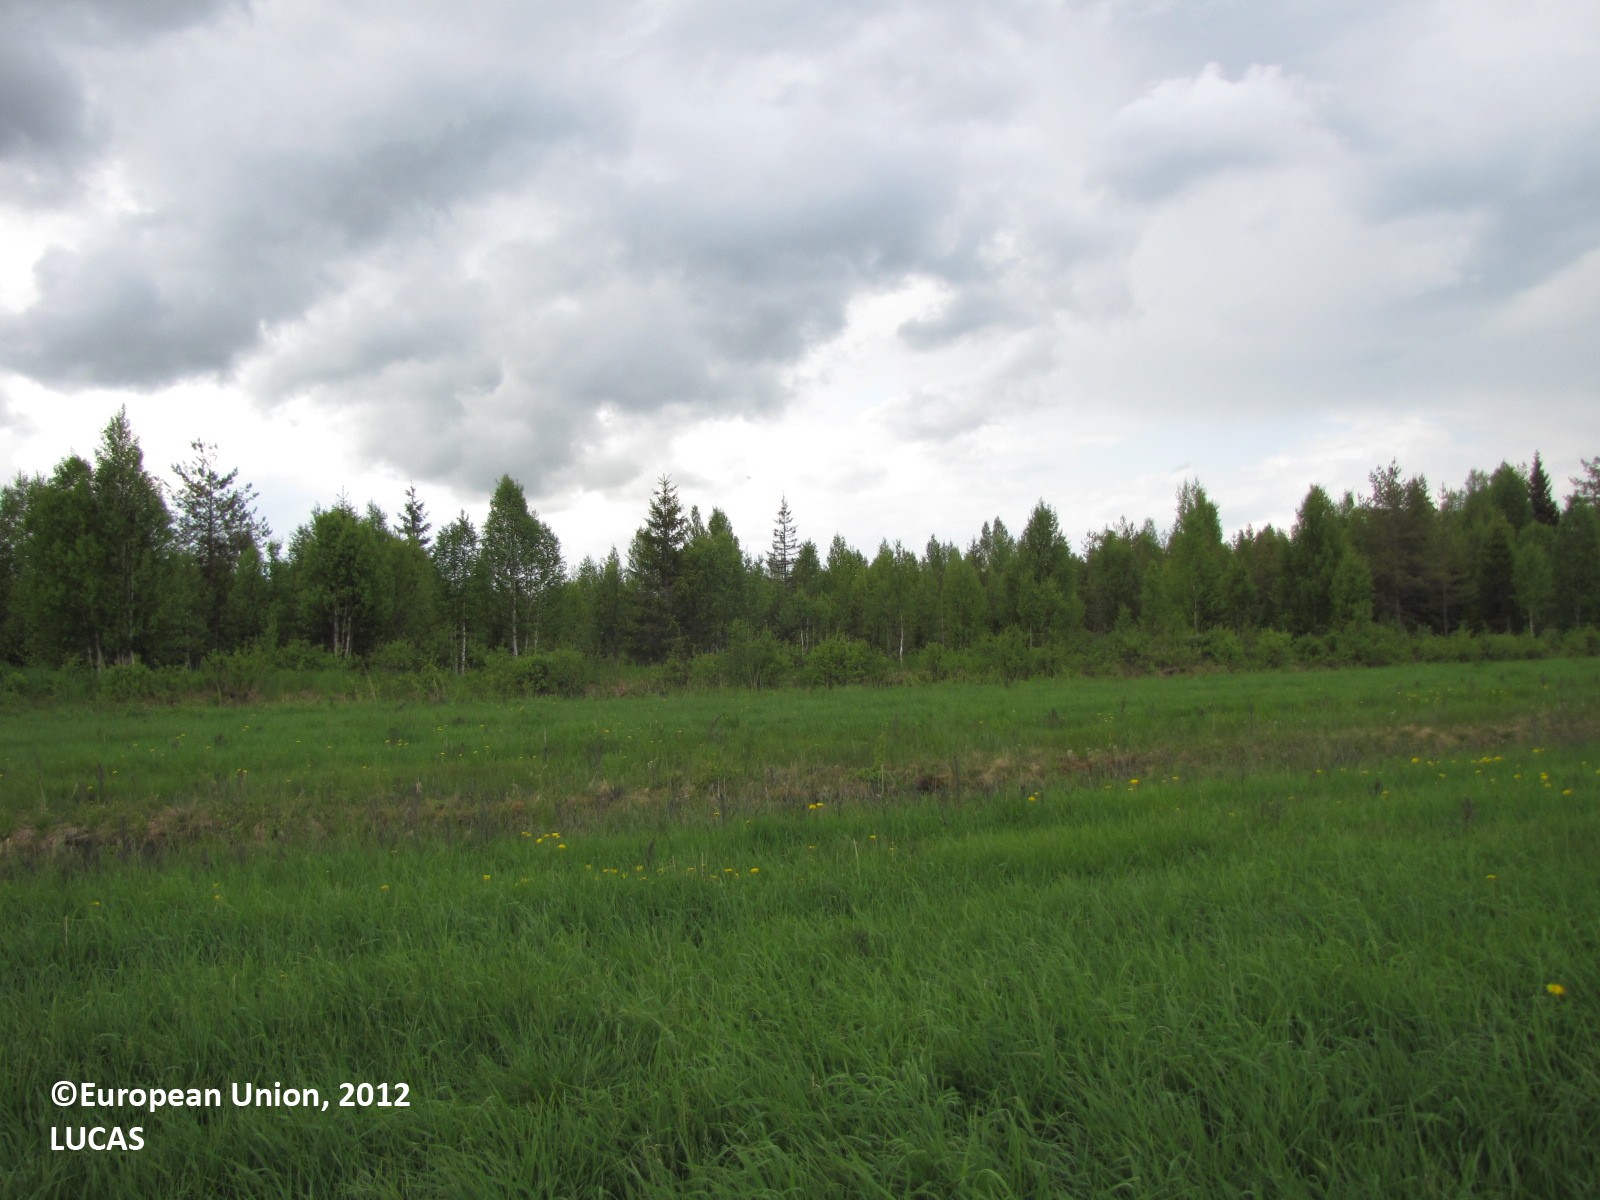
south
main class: Grassland
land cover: Grassland without tree/shrub cover
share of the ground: > 75 %
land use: Agriculture (excluding fallow land and kitchen gardens)
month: June
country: FI
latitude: 66.0910
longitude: 24.2640
